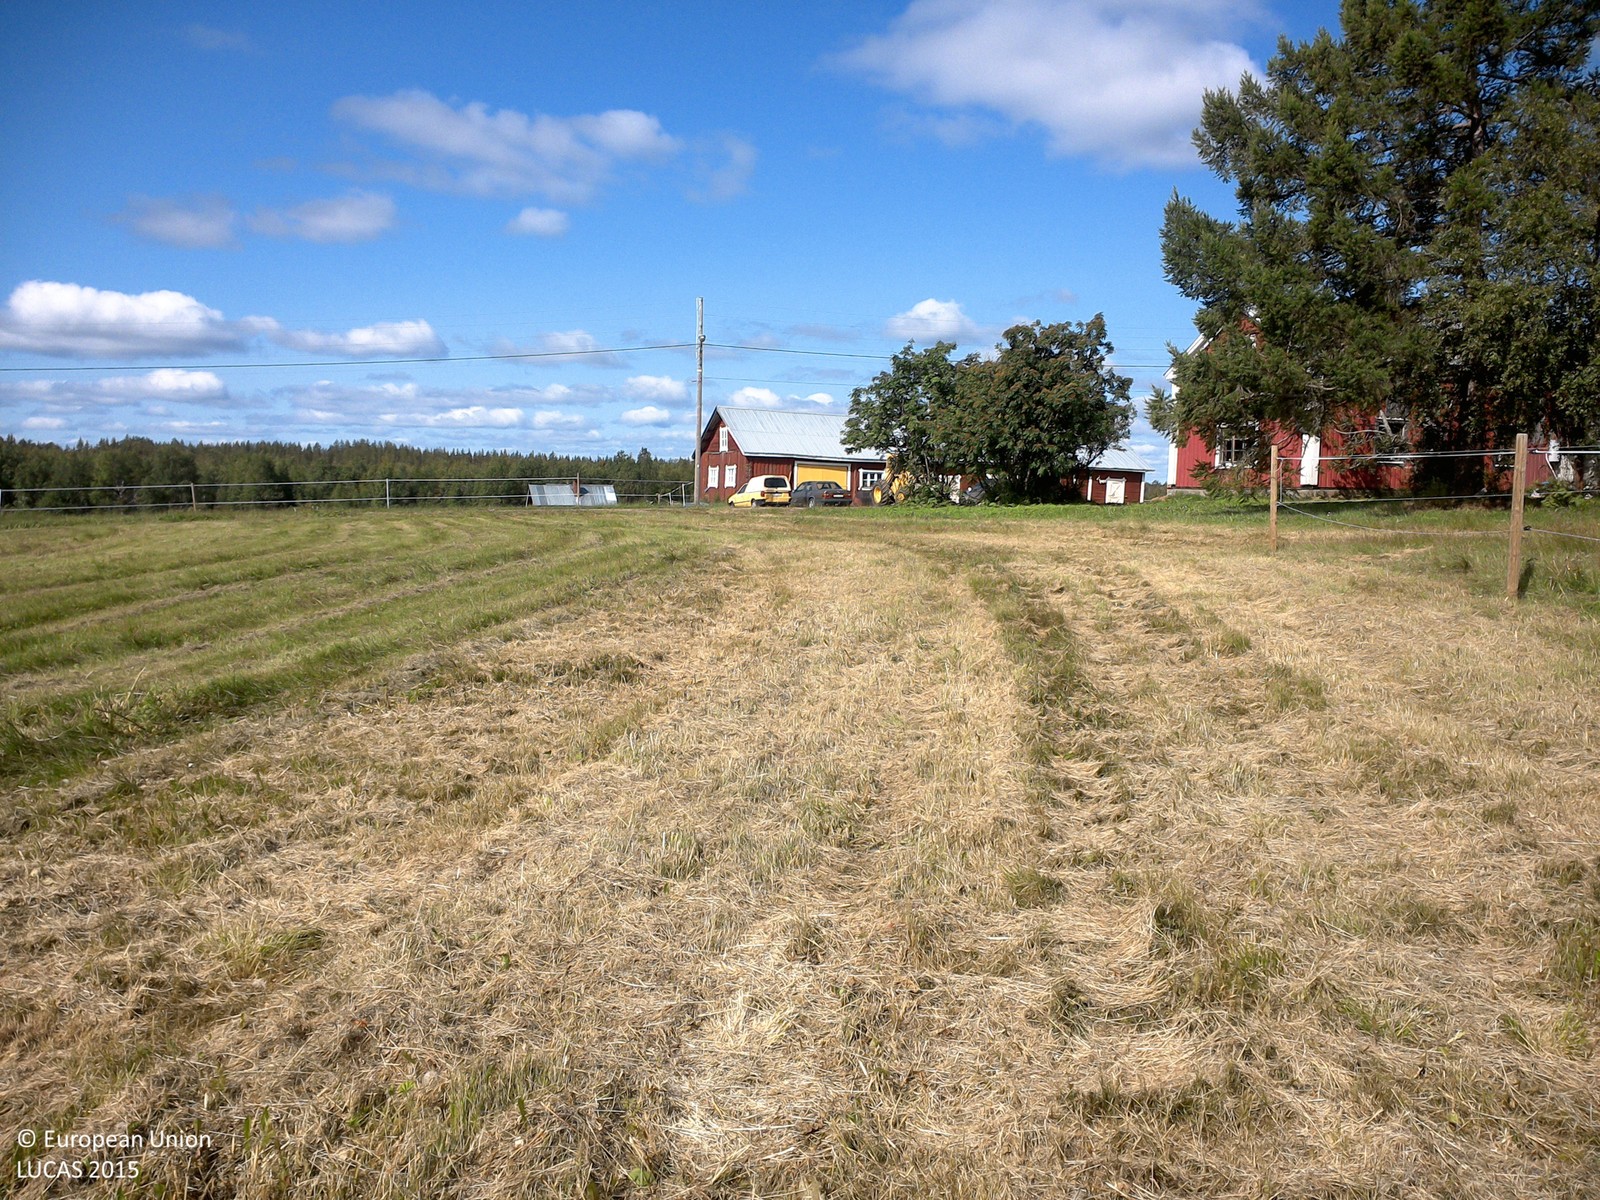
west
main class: Grassland
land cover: Grassland without tree/shrub cover
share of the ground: > 75 %
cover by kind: herbaceous plants 100 %
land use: Agriculture (excluding fallow land and kitchen gardens)
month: July
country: SE
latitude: 67.1780
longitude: 22.6478
